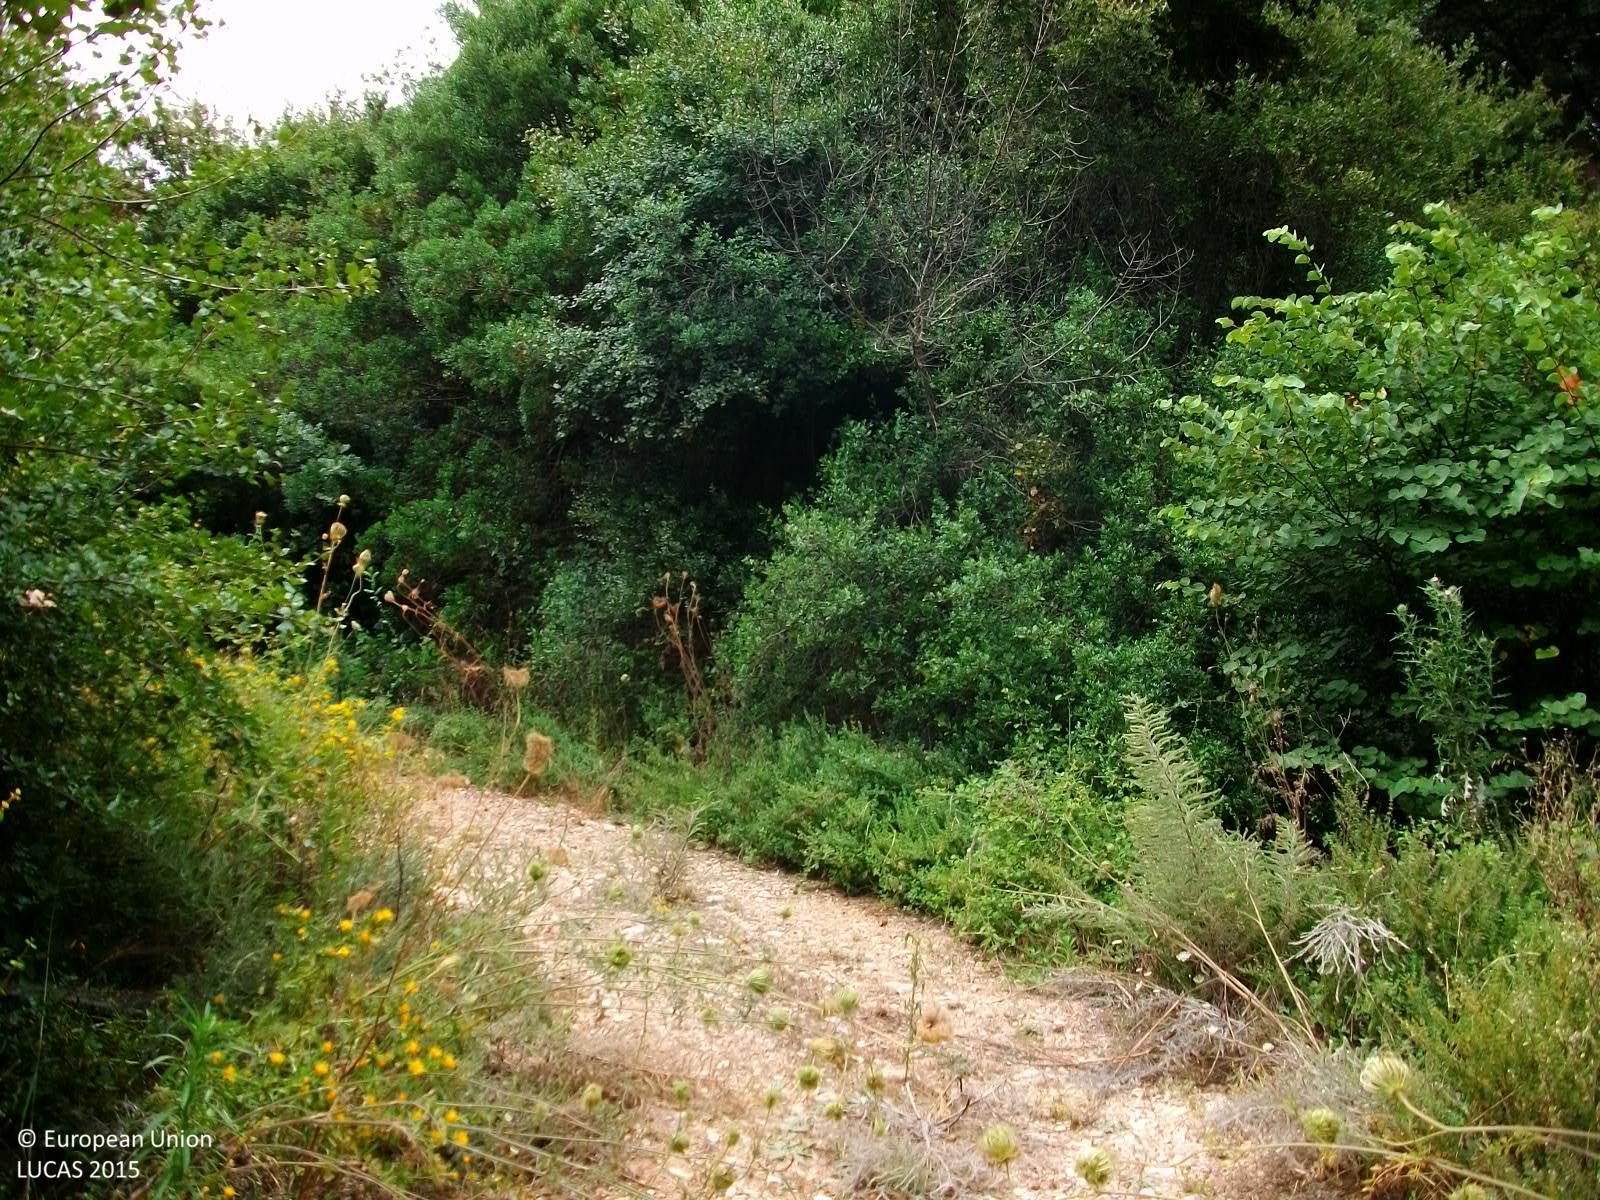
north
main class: Woodland
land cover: Broadleaved woodland
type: broadleaved evergreen forest
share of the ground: > 75 %
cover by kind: broadleaved forest trees 95 %, shrubs 5 %
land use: Semi-natural and natural areas not in use
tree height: > 5 m
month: July
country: GR
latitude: 37.0007
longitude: 21.8744
